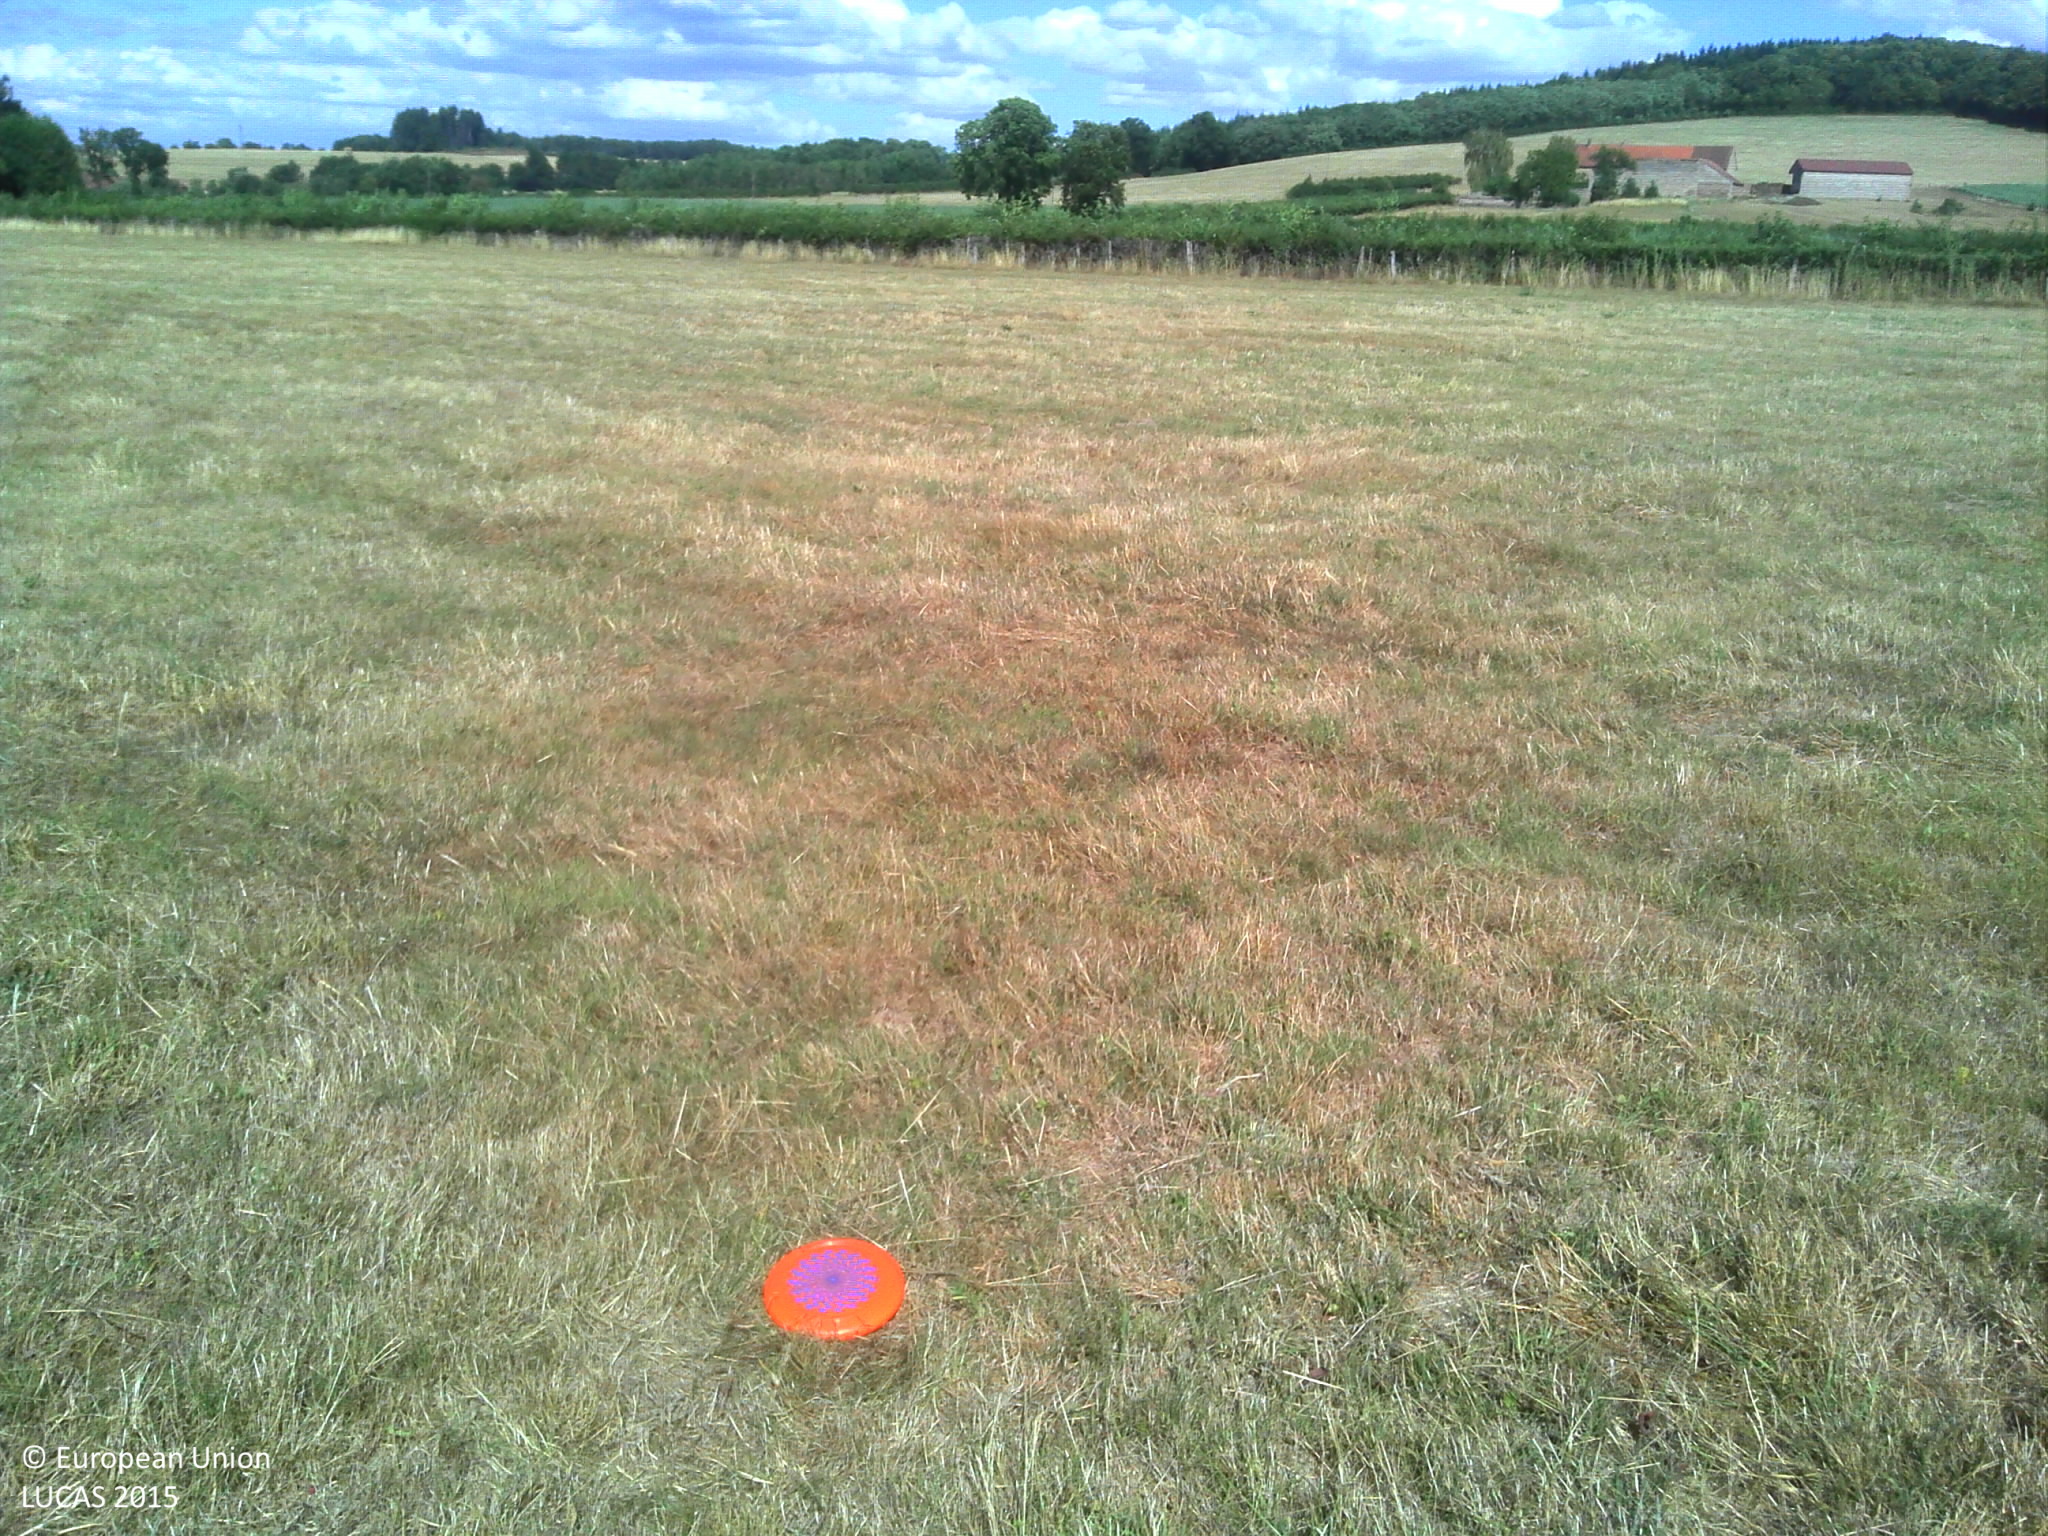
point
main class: Grassland
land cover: Grassland without tree/shrub cover
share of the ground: > 75 %
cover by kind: herbaceous plants 100 %
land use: Agriculture (excluding fallow land and kitchen gardens)
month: July
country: FR
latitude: 46.9674
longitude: 4.4932
